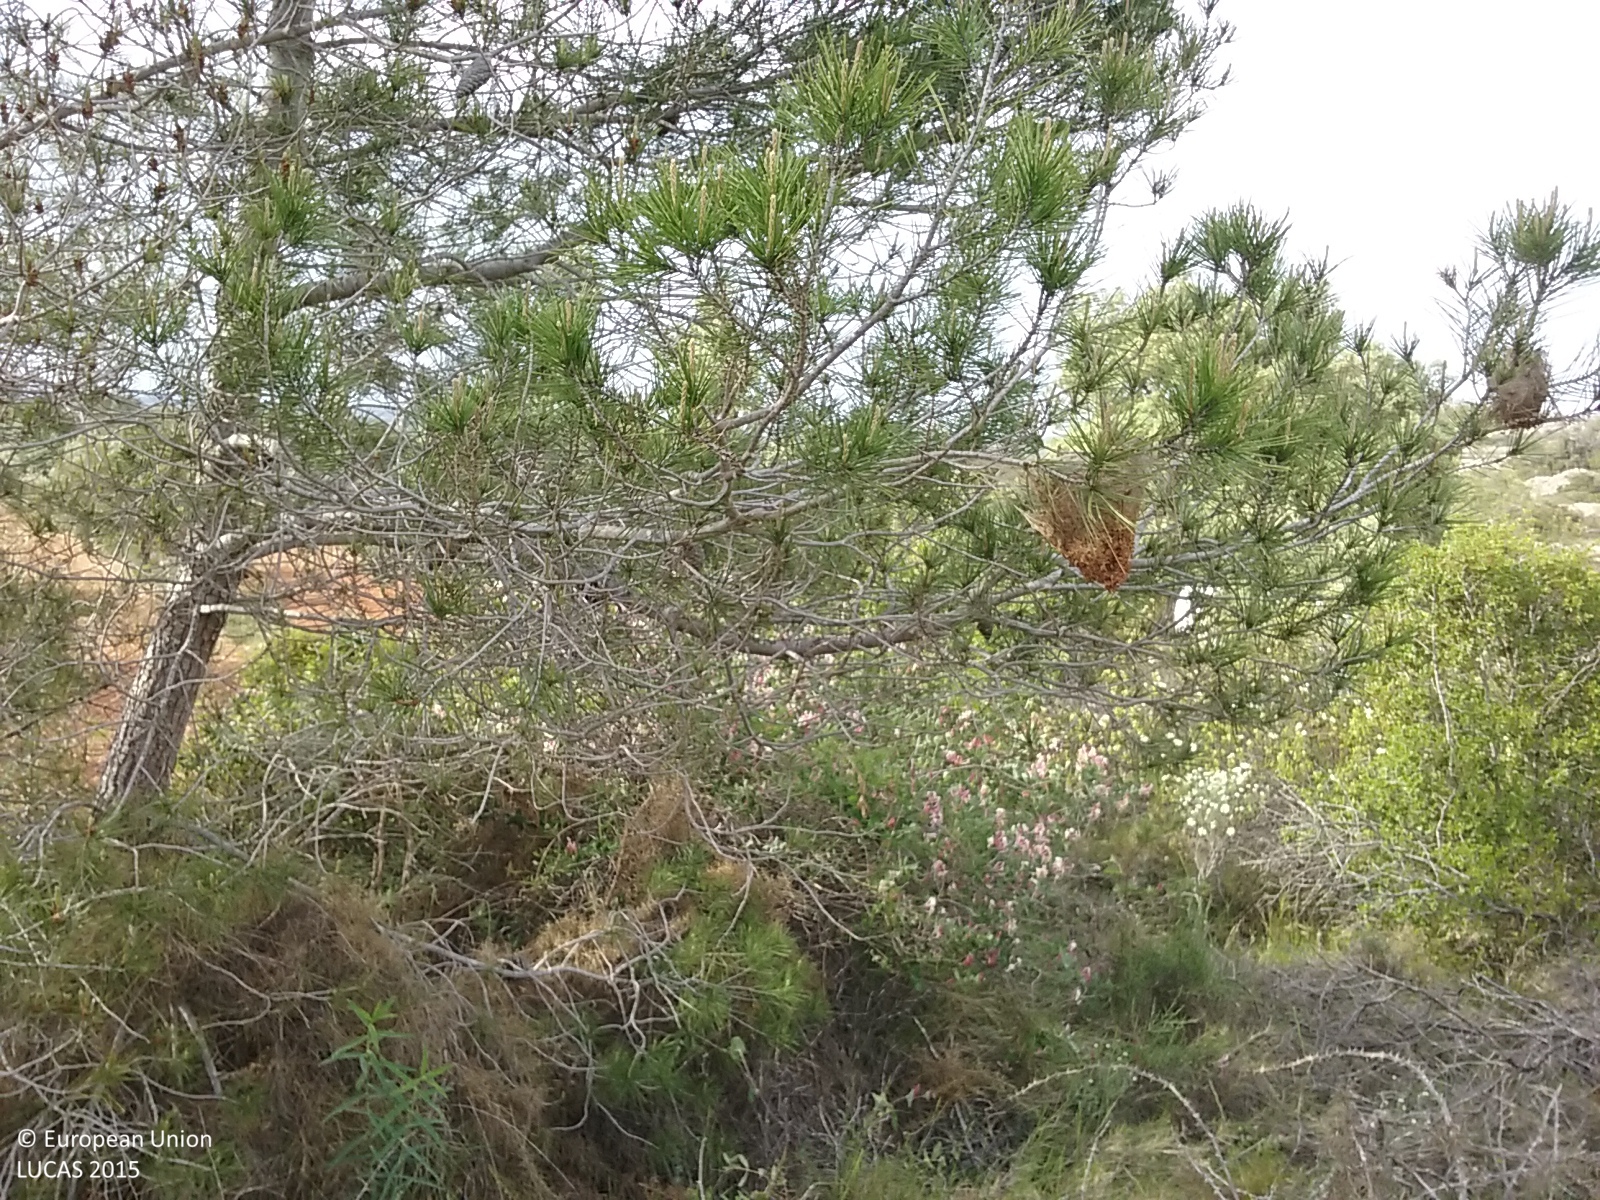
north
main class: Woodland
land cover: Pine dominated coniferous woodland
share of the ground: 10 - 25 %
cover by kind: shrubs 70 %, coniferous forest trees 15 %, broadleaved forest trees 5 %, herbaceous plants 5 %, consolidated bare surface 5 %
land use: Abandoned areas
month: May
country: ES
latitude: 40.4248
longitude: 0.3196
